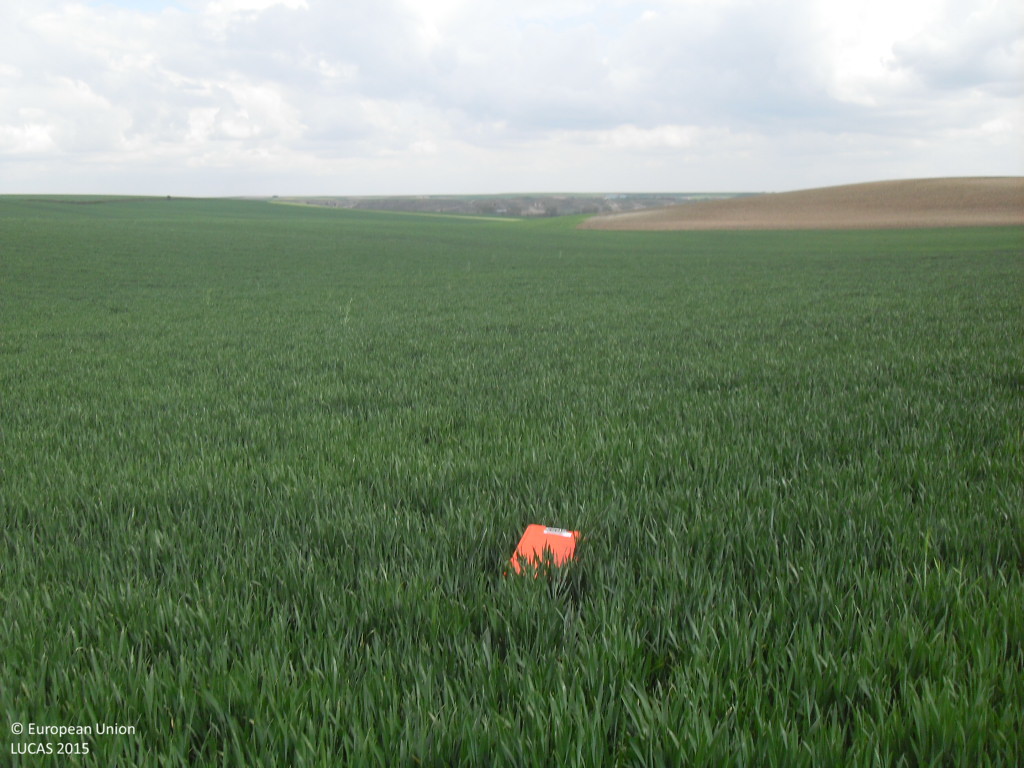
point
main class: Cropland
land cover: Common wheat
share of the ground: > 75 %
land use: Agriculture (excluding fallow land and kitchen gardens)
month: April
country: ES
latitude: 40.8009
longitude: -5.3231
